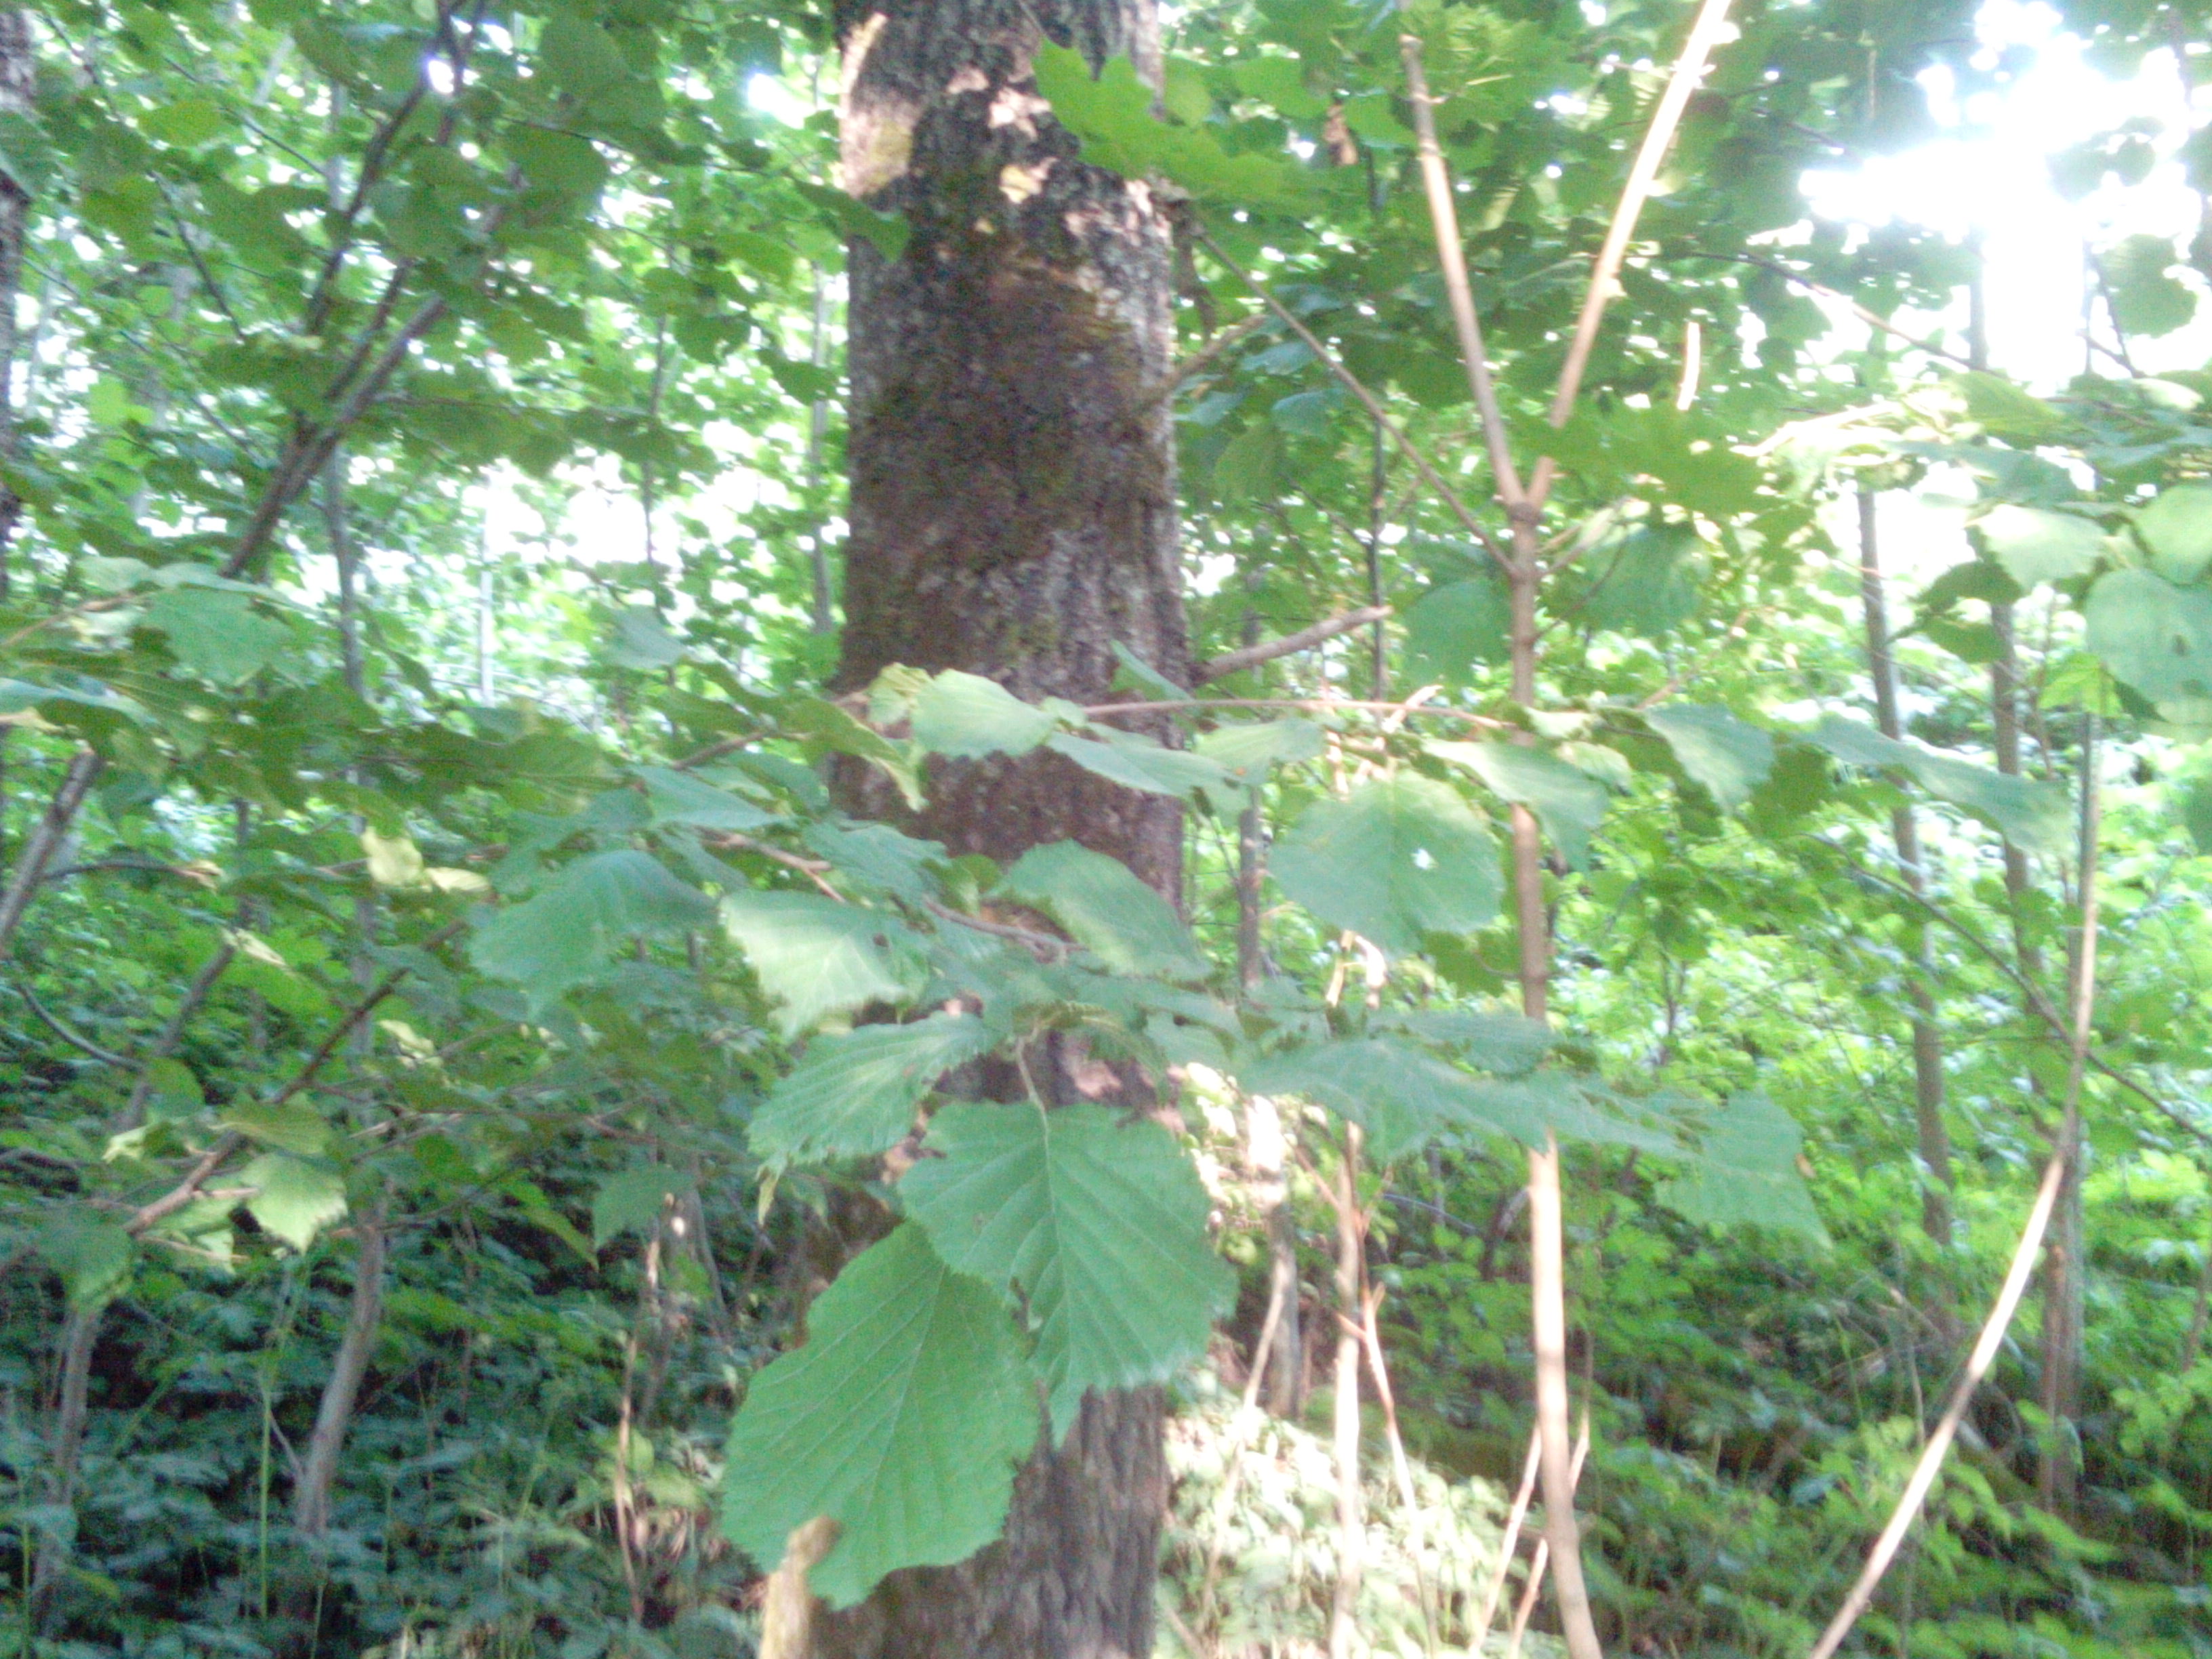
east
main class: Woodland
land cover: Broadleaved woodland
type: non-riverine alder, birch or aspen forest
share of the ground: > 75 %
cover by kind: broadleaved forest trees 85 %, herbaceous plants 10 %, shrubs 5 %
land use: Forestry
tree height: > 5 m
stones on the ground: < 10 %
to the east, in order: Broadleaved woodland; Shruby margins; Paved roads, cycling and walking lanes; Shruby margins; Ditches and canals; Broadleaved woodland; Fences; Grassland without tree/shrub cover; Electric lines; Grassland without tree/shrub cover; Broadleaved woodland; Spontaneously vegetated surfaces; Inland marshes; Inland fresh water bodies; Inland marshes; Broadleaved woodland
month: July
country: LV
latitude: 56.5118
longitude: 21.8283
